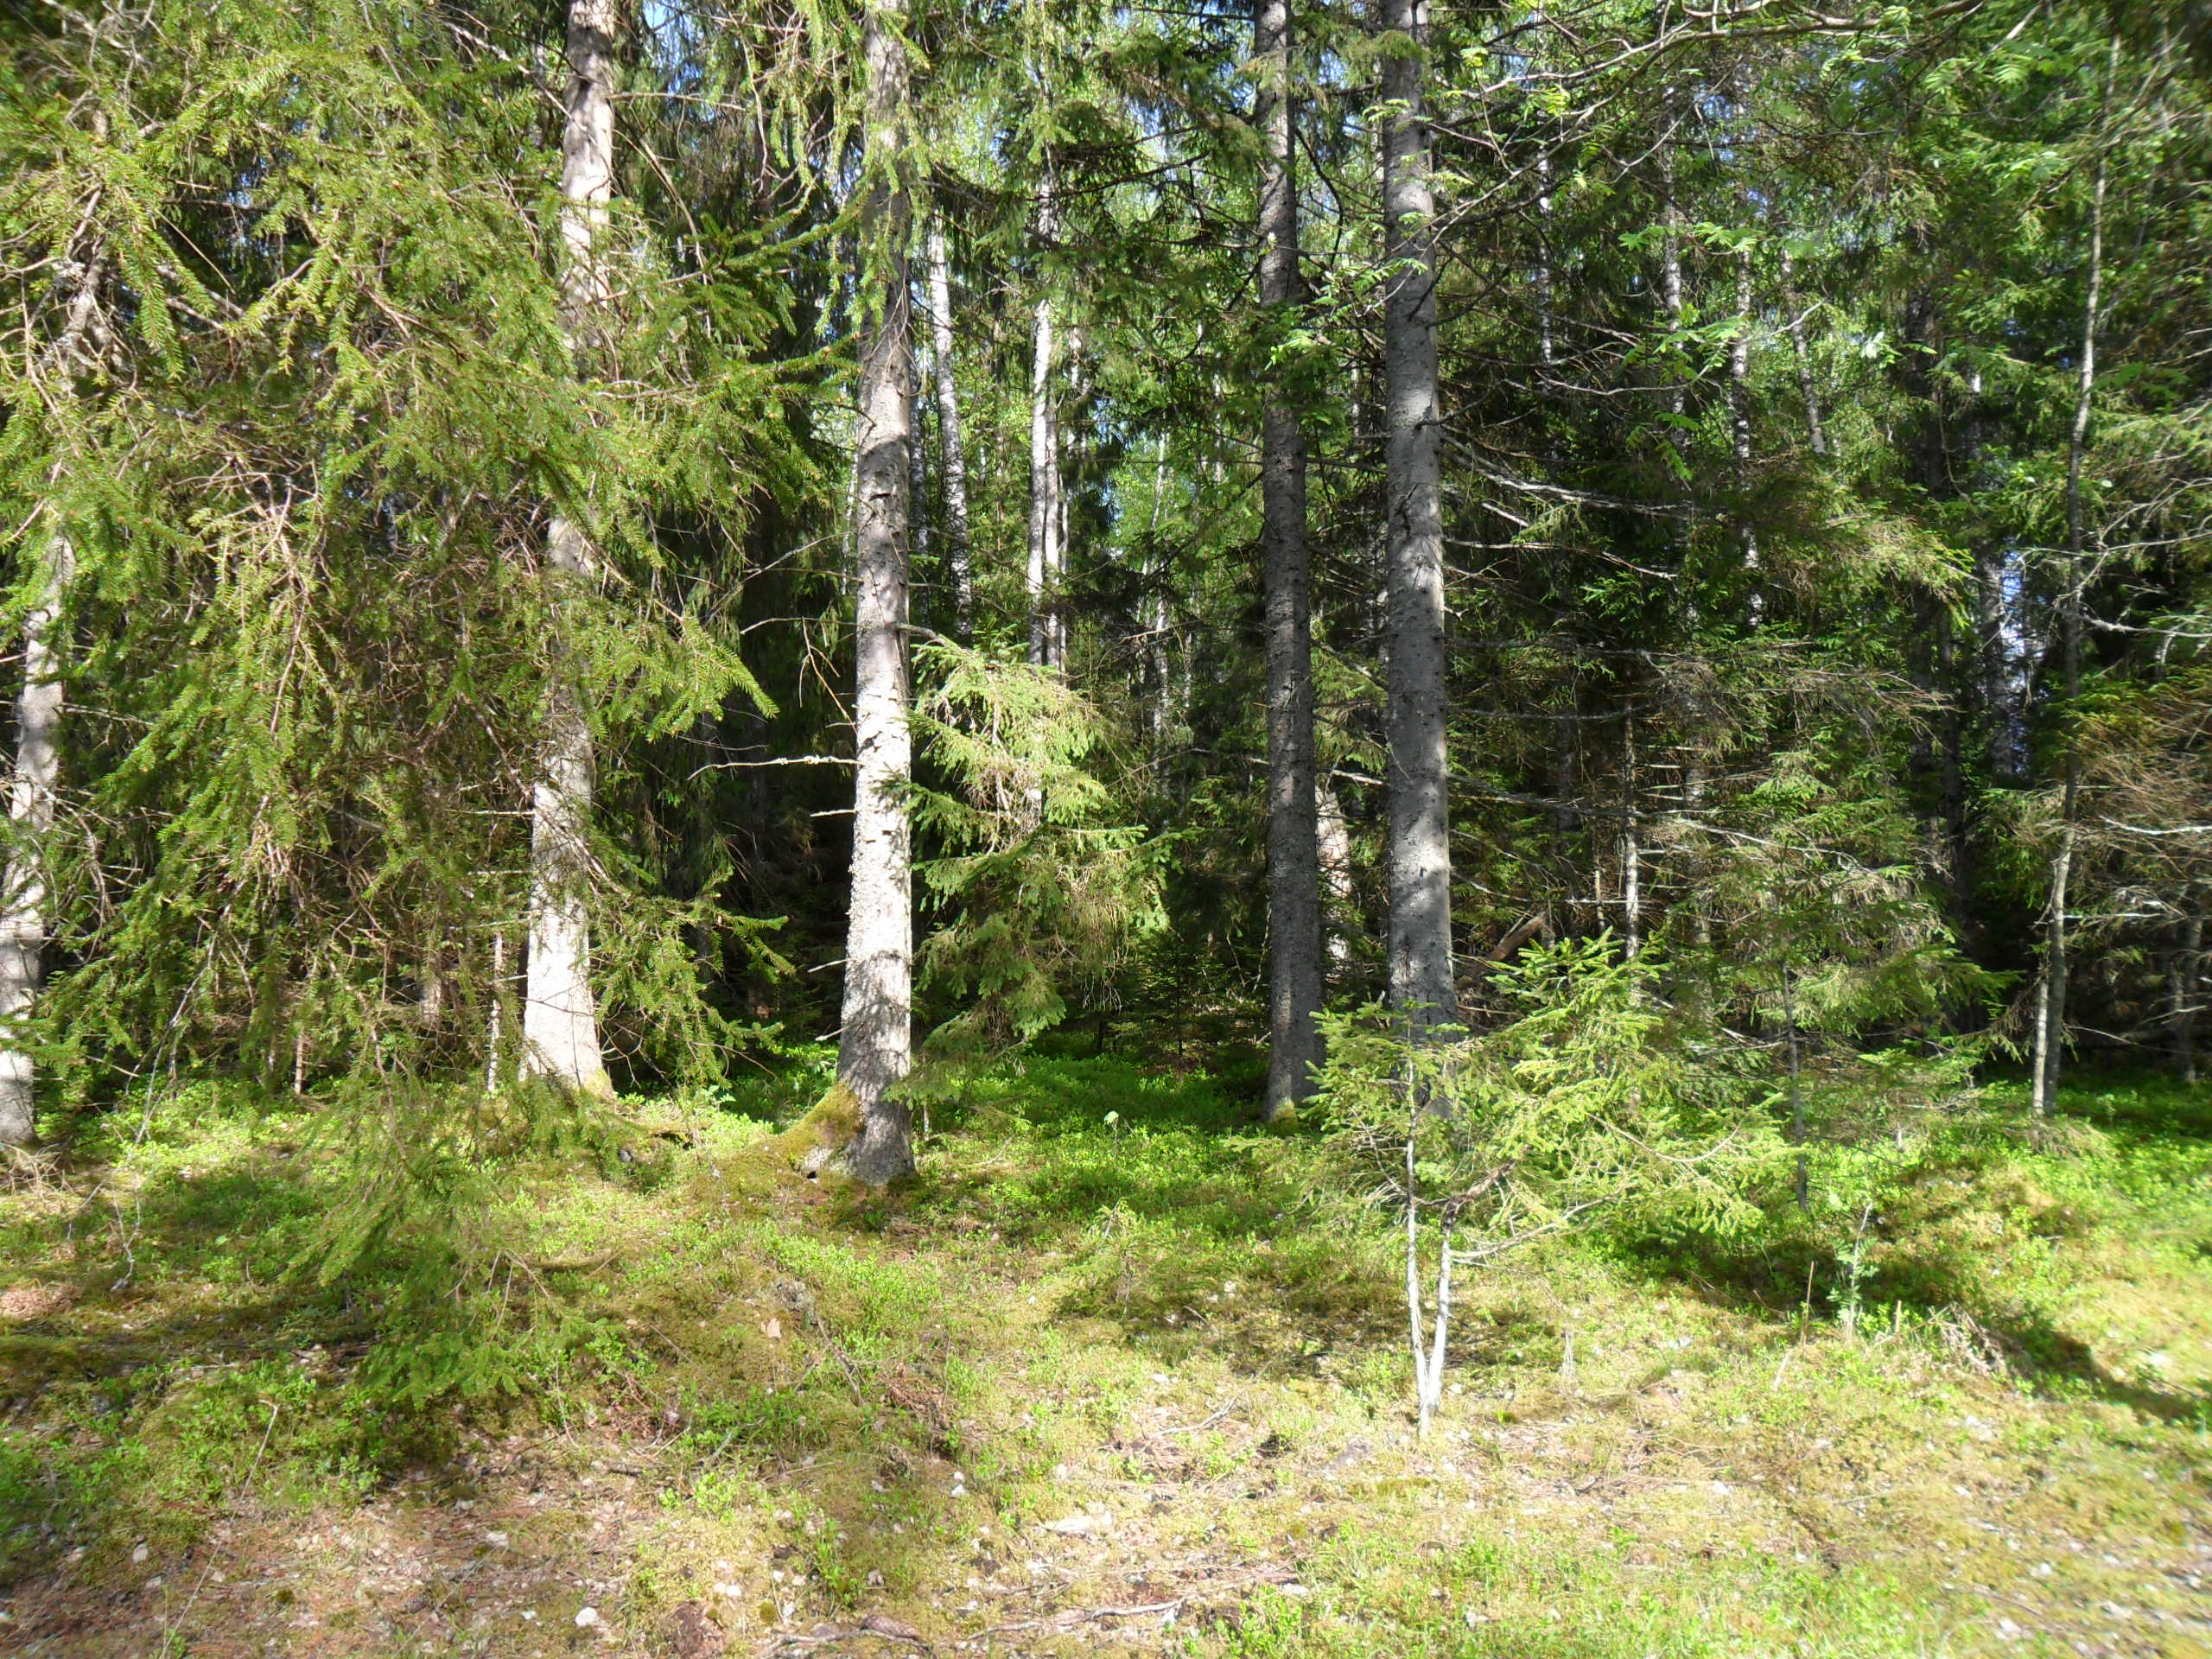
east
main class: Woodland
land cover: Other mixed woodland
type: hemiboreal forest and nemoral coniferous forest and mixed broadleaved-coniferous forest
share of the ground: > 75 %
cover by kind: coniferous forest trees 45 %, broadleaved forest trees 45 %, shrubs 10 %
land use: Forestry
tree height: > 5 m
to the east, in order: Other mixed woodland; Spruce dominated mixed woodland; Pine dominated coniferous woodland
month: May
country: LV
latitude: 57.1856
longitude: 22.4121
